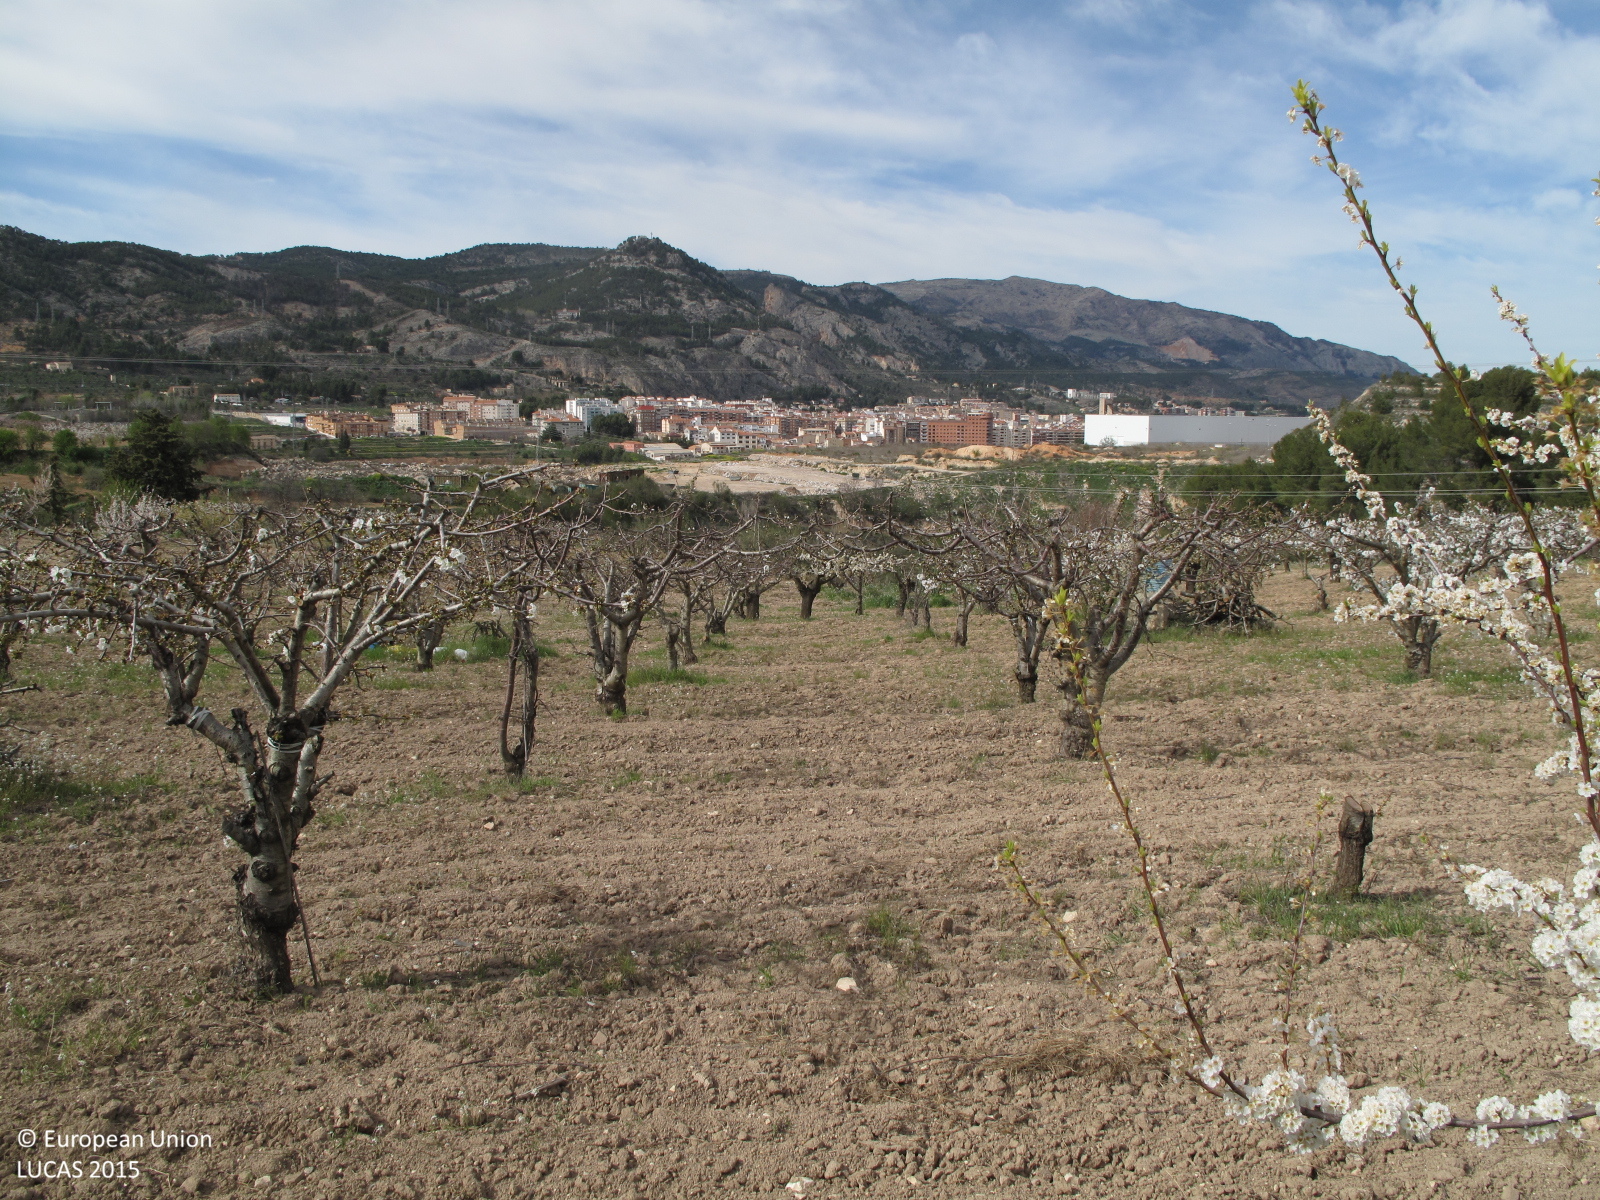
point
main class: Cropland
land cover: Cherry fruit
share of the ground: 25 - 50 %
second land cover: Other bare soil
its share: > 75 %
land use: Agriculture (excluding fallow land and kitchen gardens)
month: March
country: ES
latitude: 38.6824
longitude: -0.4845
